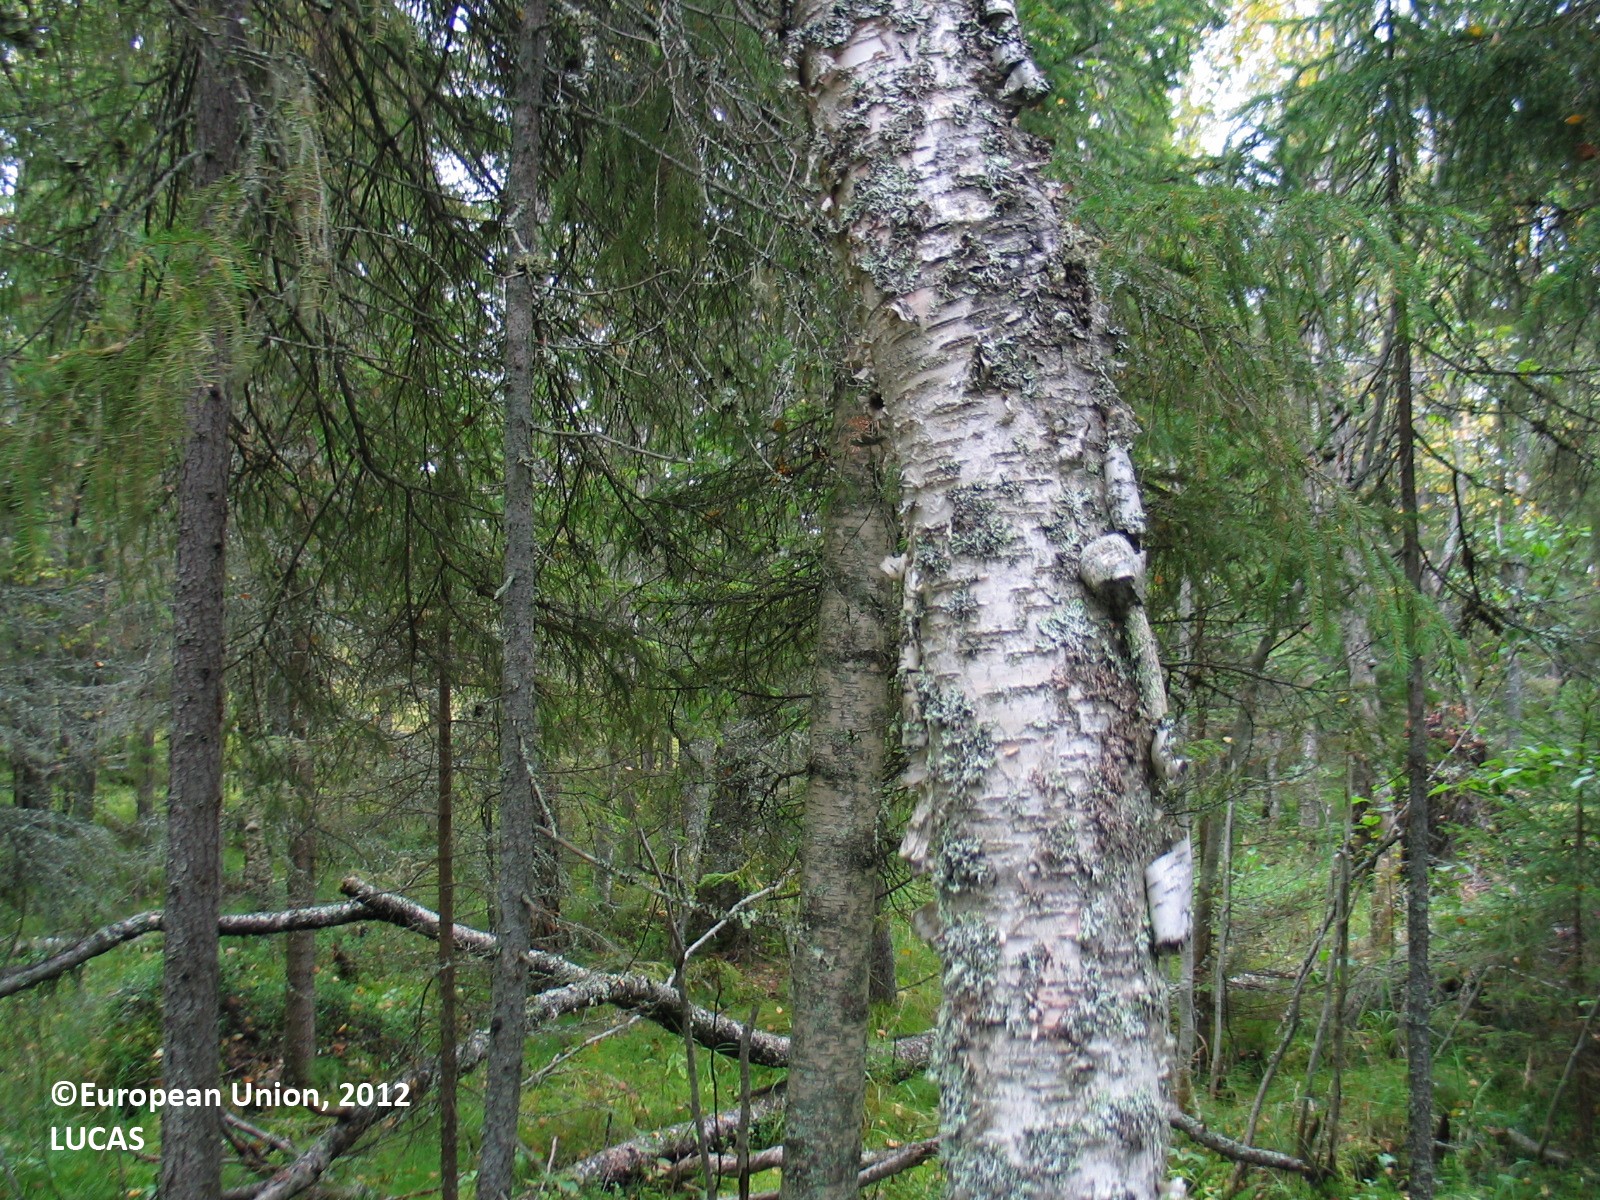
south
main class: Woodland
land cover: Spruce dominated mixed woodland
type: mire and swamp forests
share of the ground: 50 - 75 %
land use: Forestry
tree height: > 5 m
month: September
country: FI
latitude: 65.6092
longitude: 25.1071
